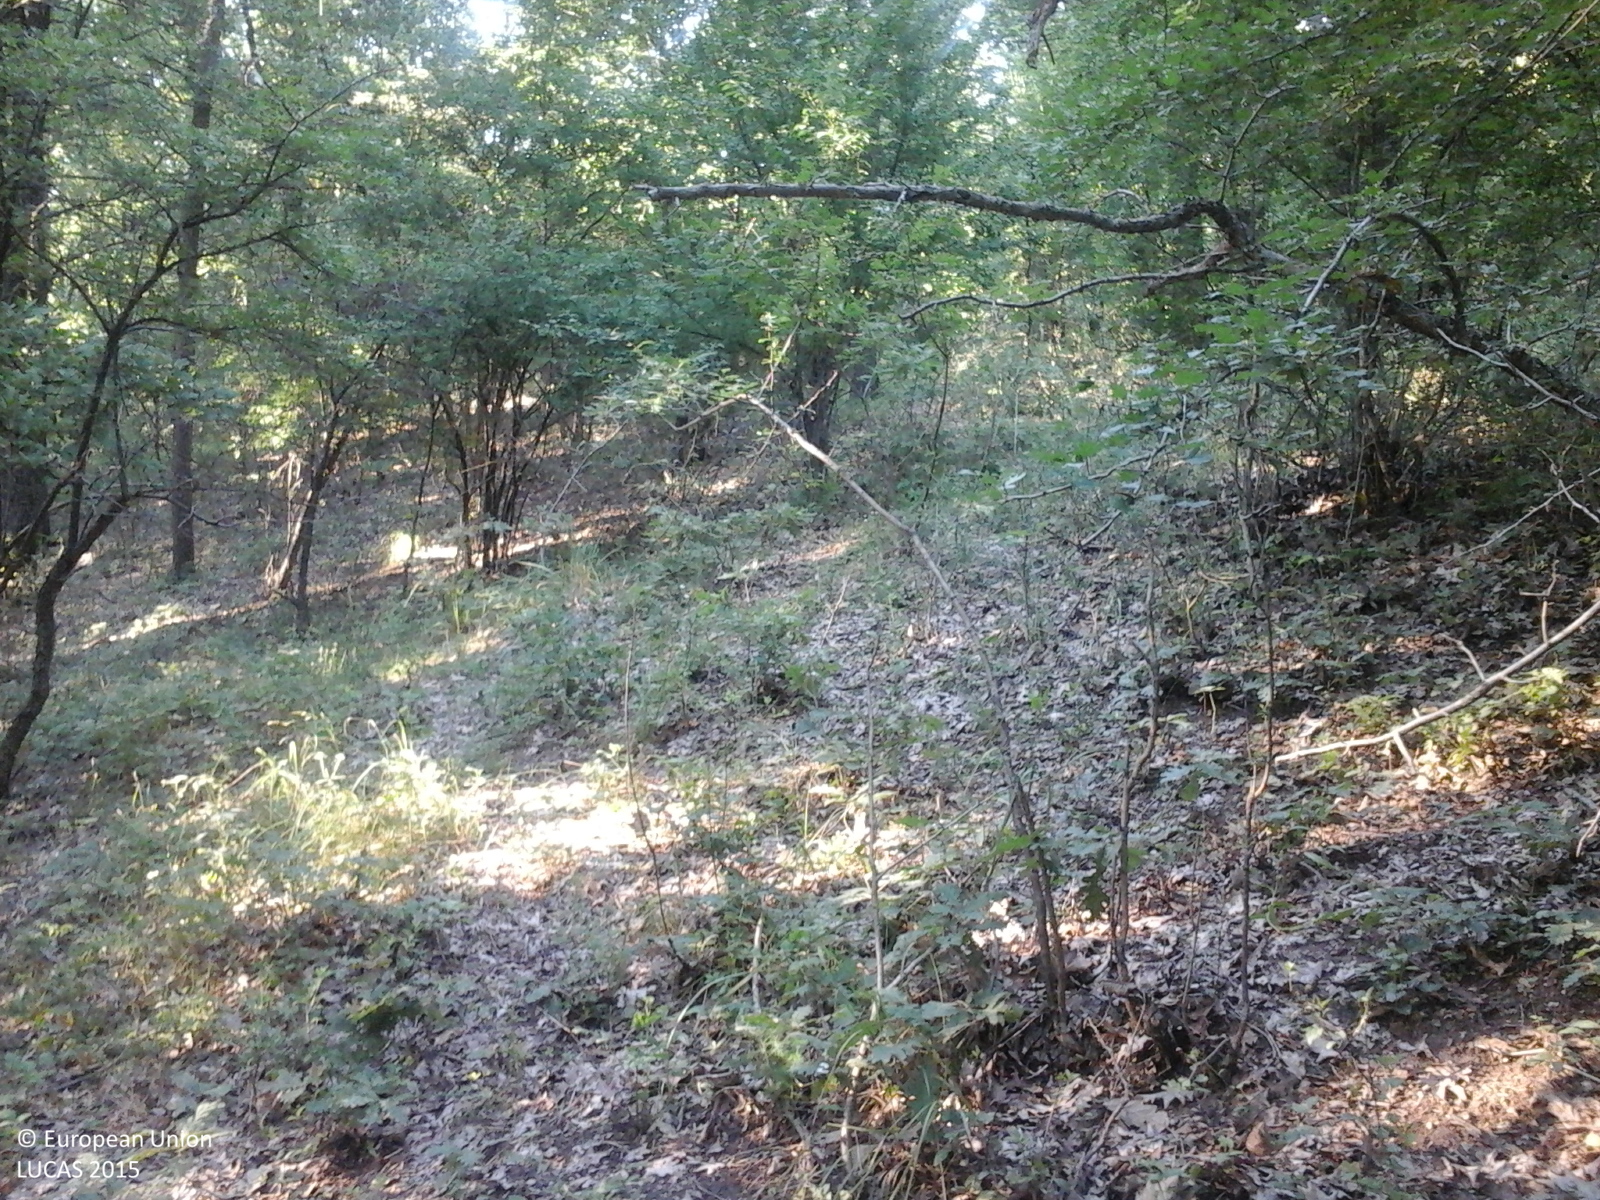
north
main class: Woodland
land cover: Broadleaved woodland
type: acidophilous oak and oak-birch forest
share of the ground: > 75 %
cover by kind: broadleaved forest trees 95 %, herbaceous plants 5 %
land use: Forestry
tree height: > 5 m
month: July
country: RO
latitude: 44.5646
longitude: 24.5393
